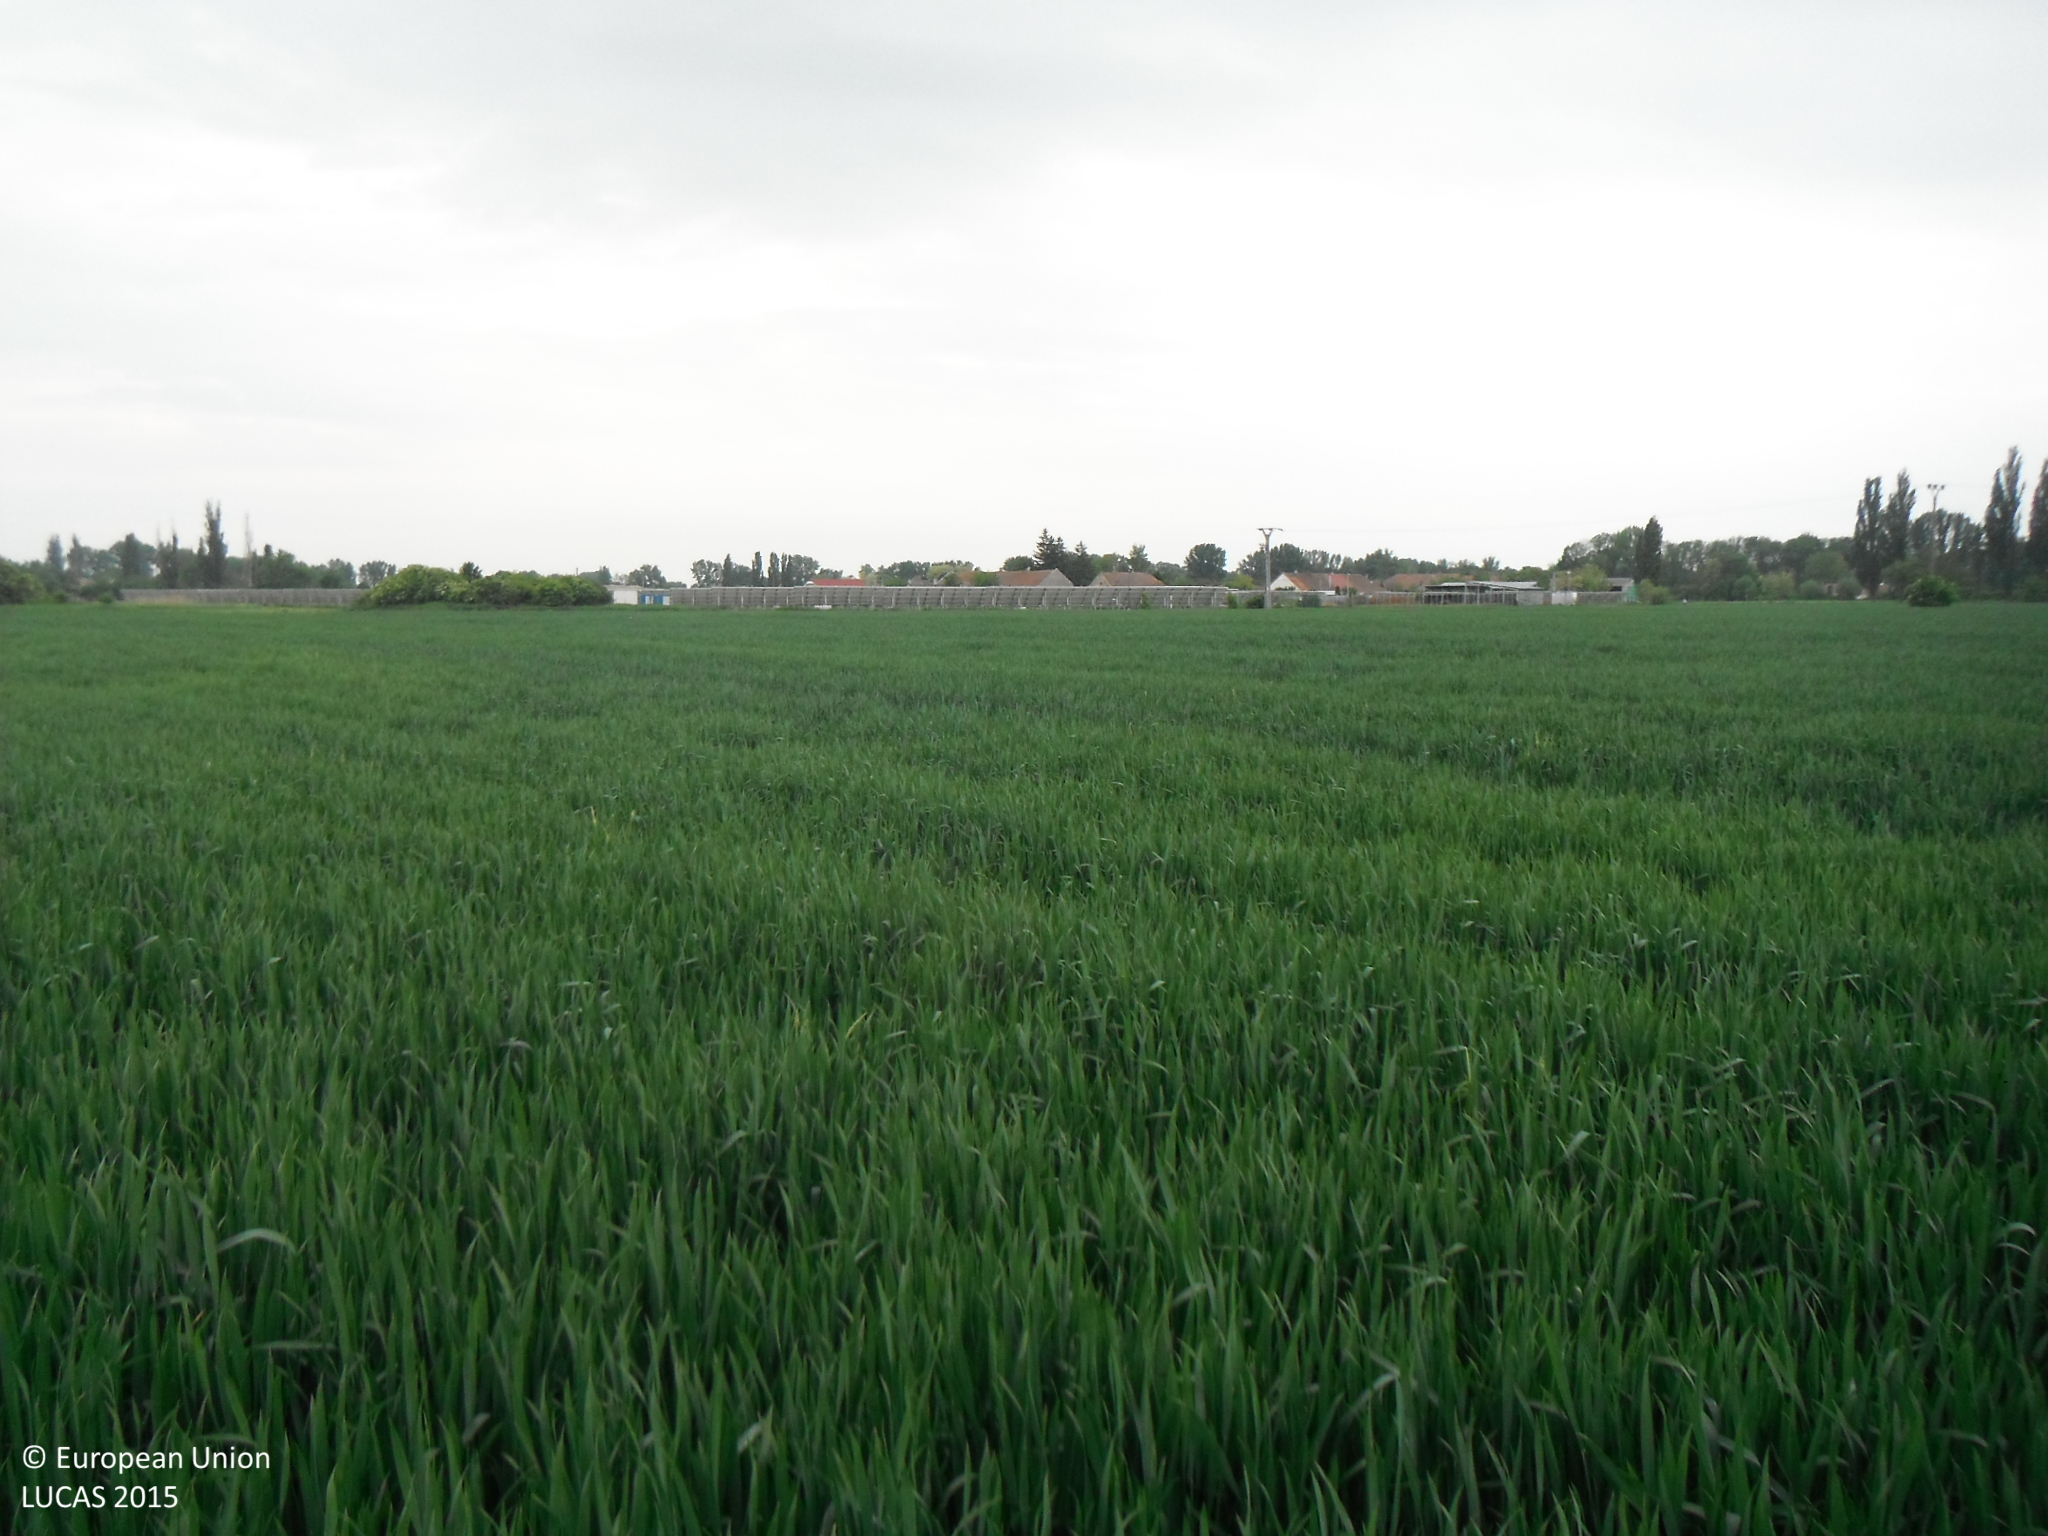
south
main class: Cropland
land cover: Common wheat
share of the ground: > 75 %
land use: Agriculture (excluding fallow land and kitchen gardens)
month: May
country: SK
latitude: 47.8657
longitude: 17.6699
